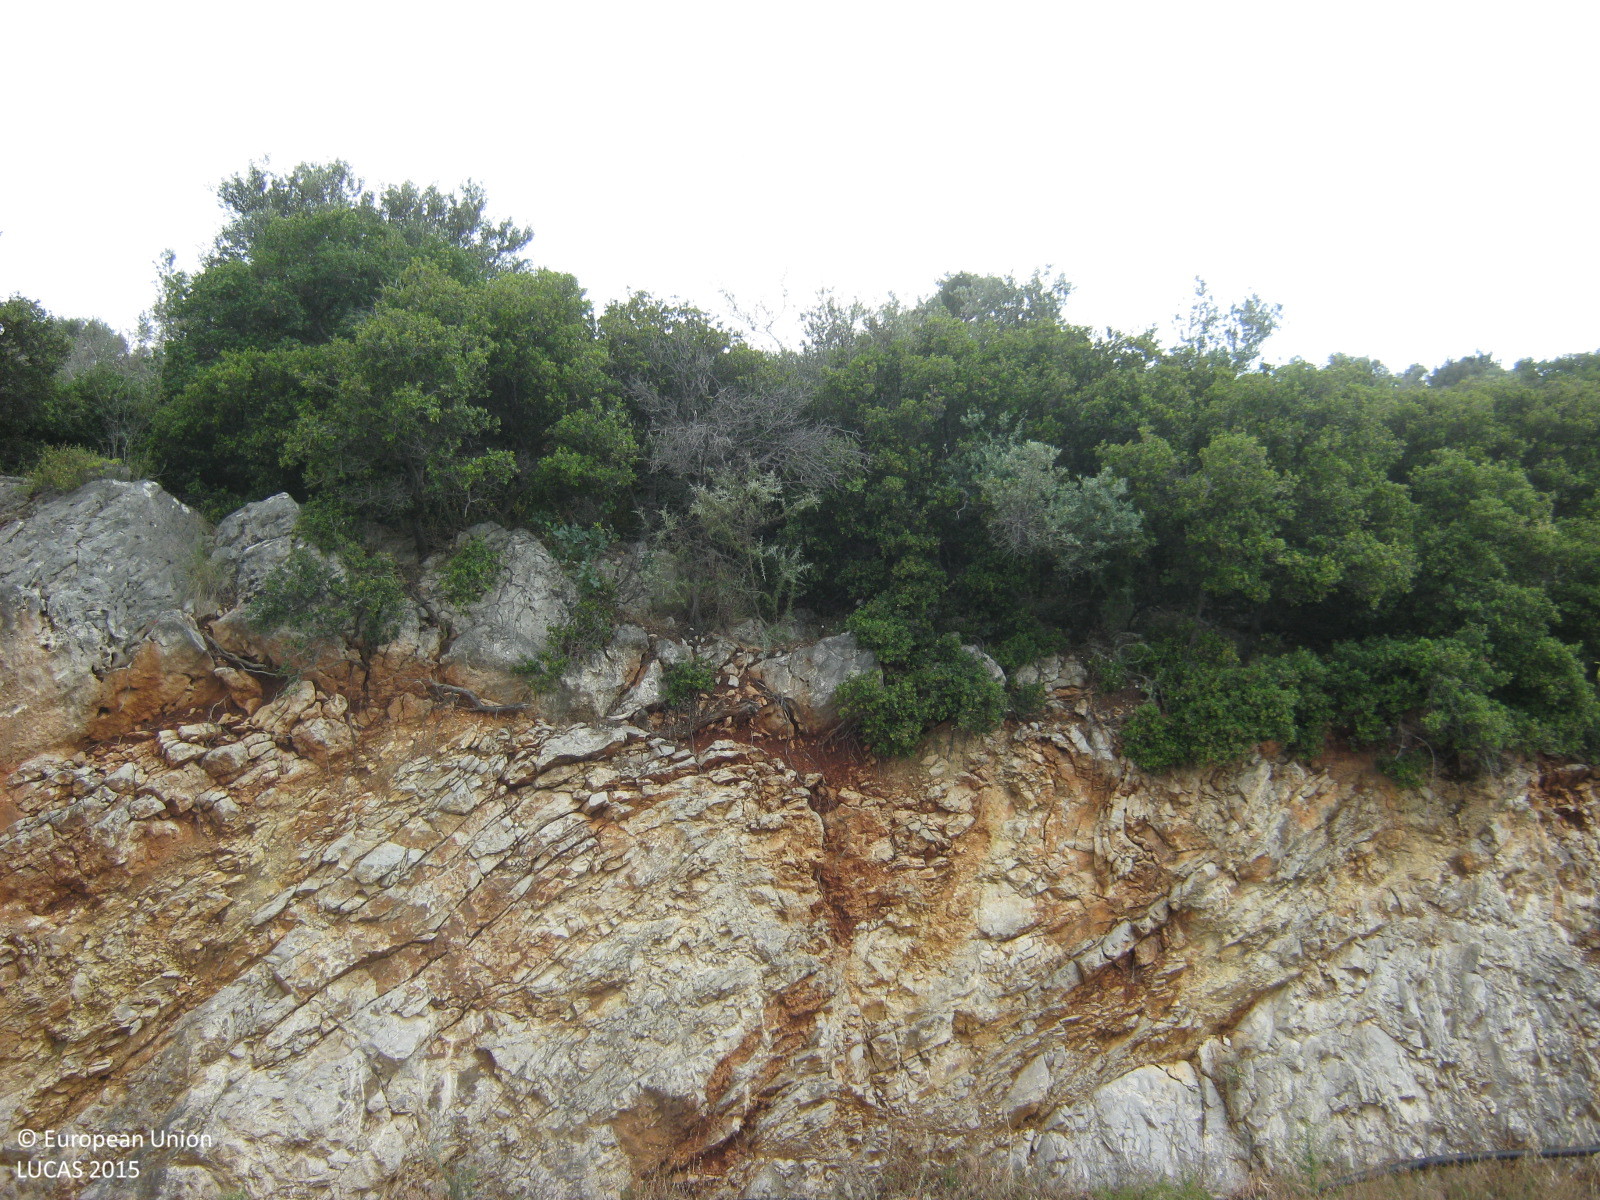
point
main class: Shrubland
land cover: Shrubland with sparse tree cover
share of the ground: > 75 %
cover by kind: shrubs 95 %, broadleaved forest trees 5 %
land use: Semi-natural and natural areas not in use
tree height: < 5 m
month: June
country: GR
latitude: 37.5107
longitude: 22.7370
